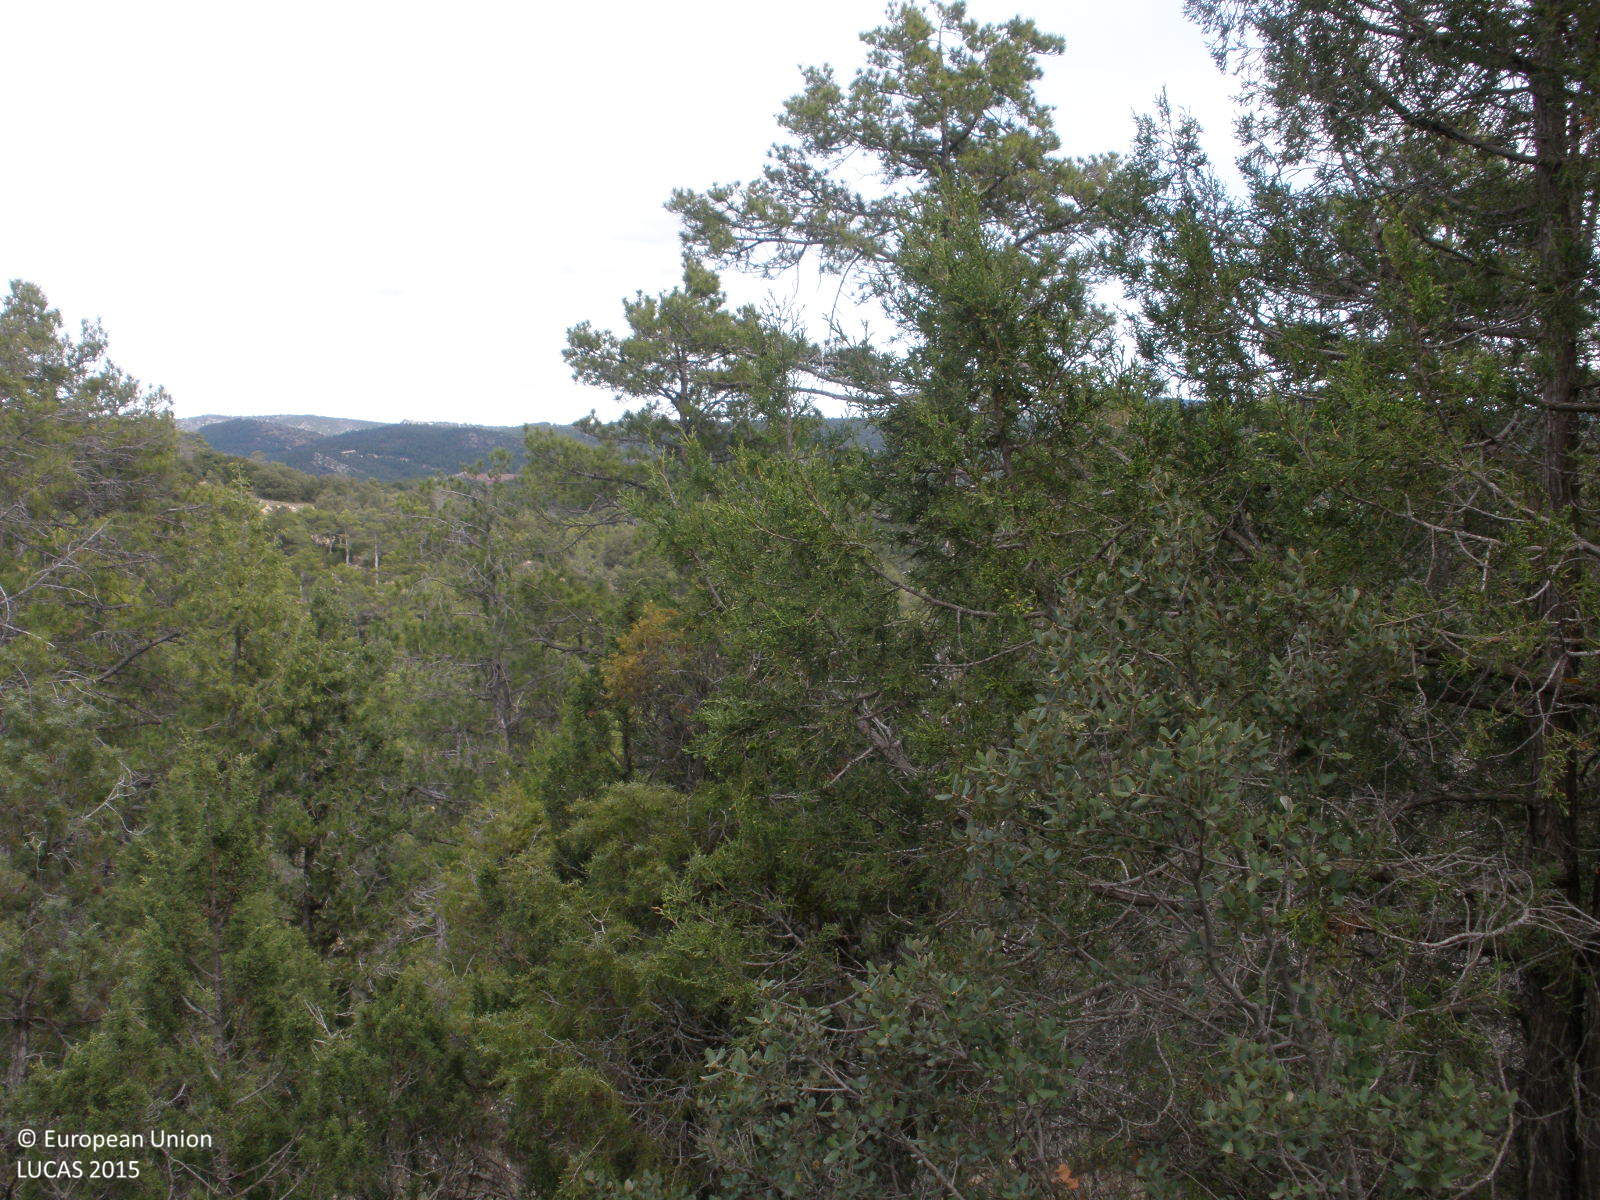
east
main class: Woodland
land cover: Pine dominated coniferous woodland
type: coniferous forest of the mediterranean region
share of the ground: > 75 %
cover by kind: coniferous forest trees 50 %, shrubs 40 %, consolidated bare surface 10 %
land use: Semi-natural and natural areas not in use
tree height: > 5 m
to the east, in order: Pine dominated coniferous woodland
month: April
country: ES
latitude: 40.3766
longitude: -0.9993
